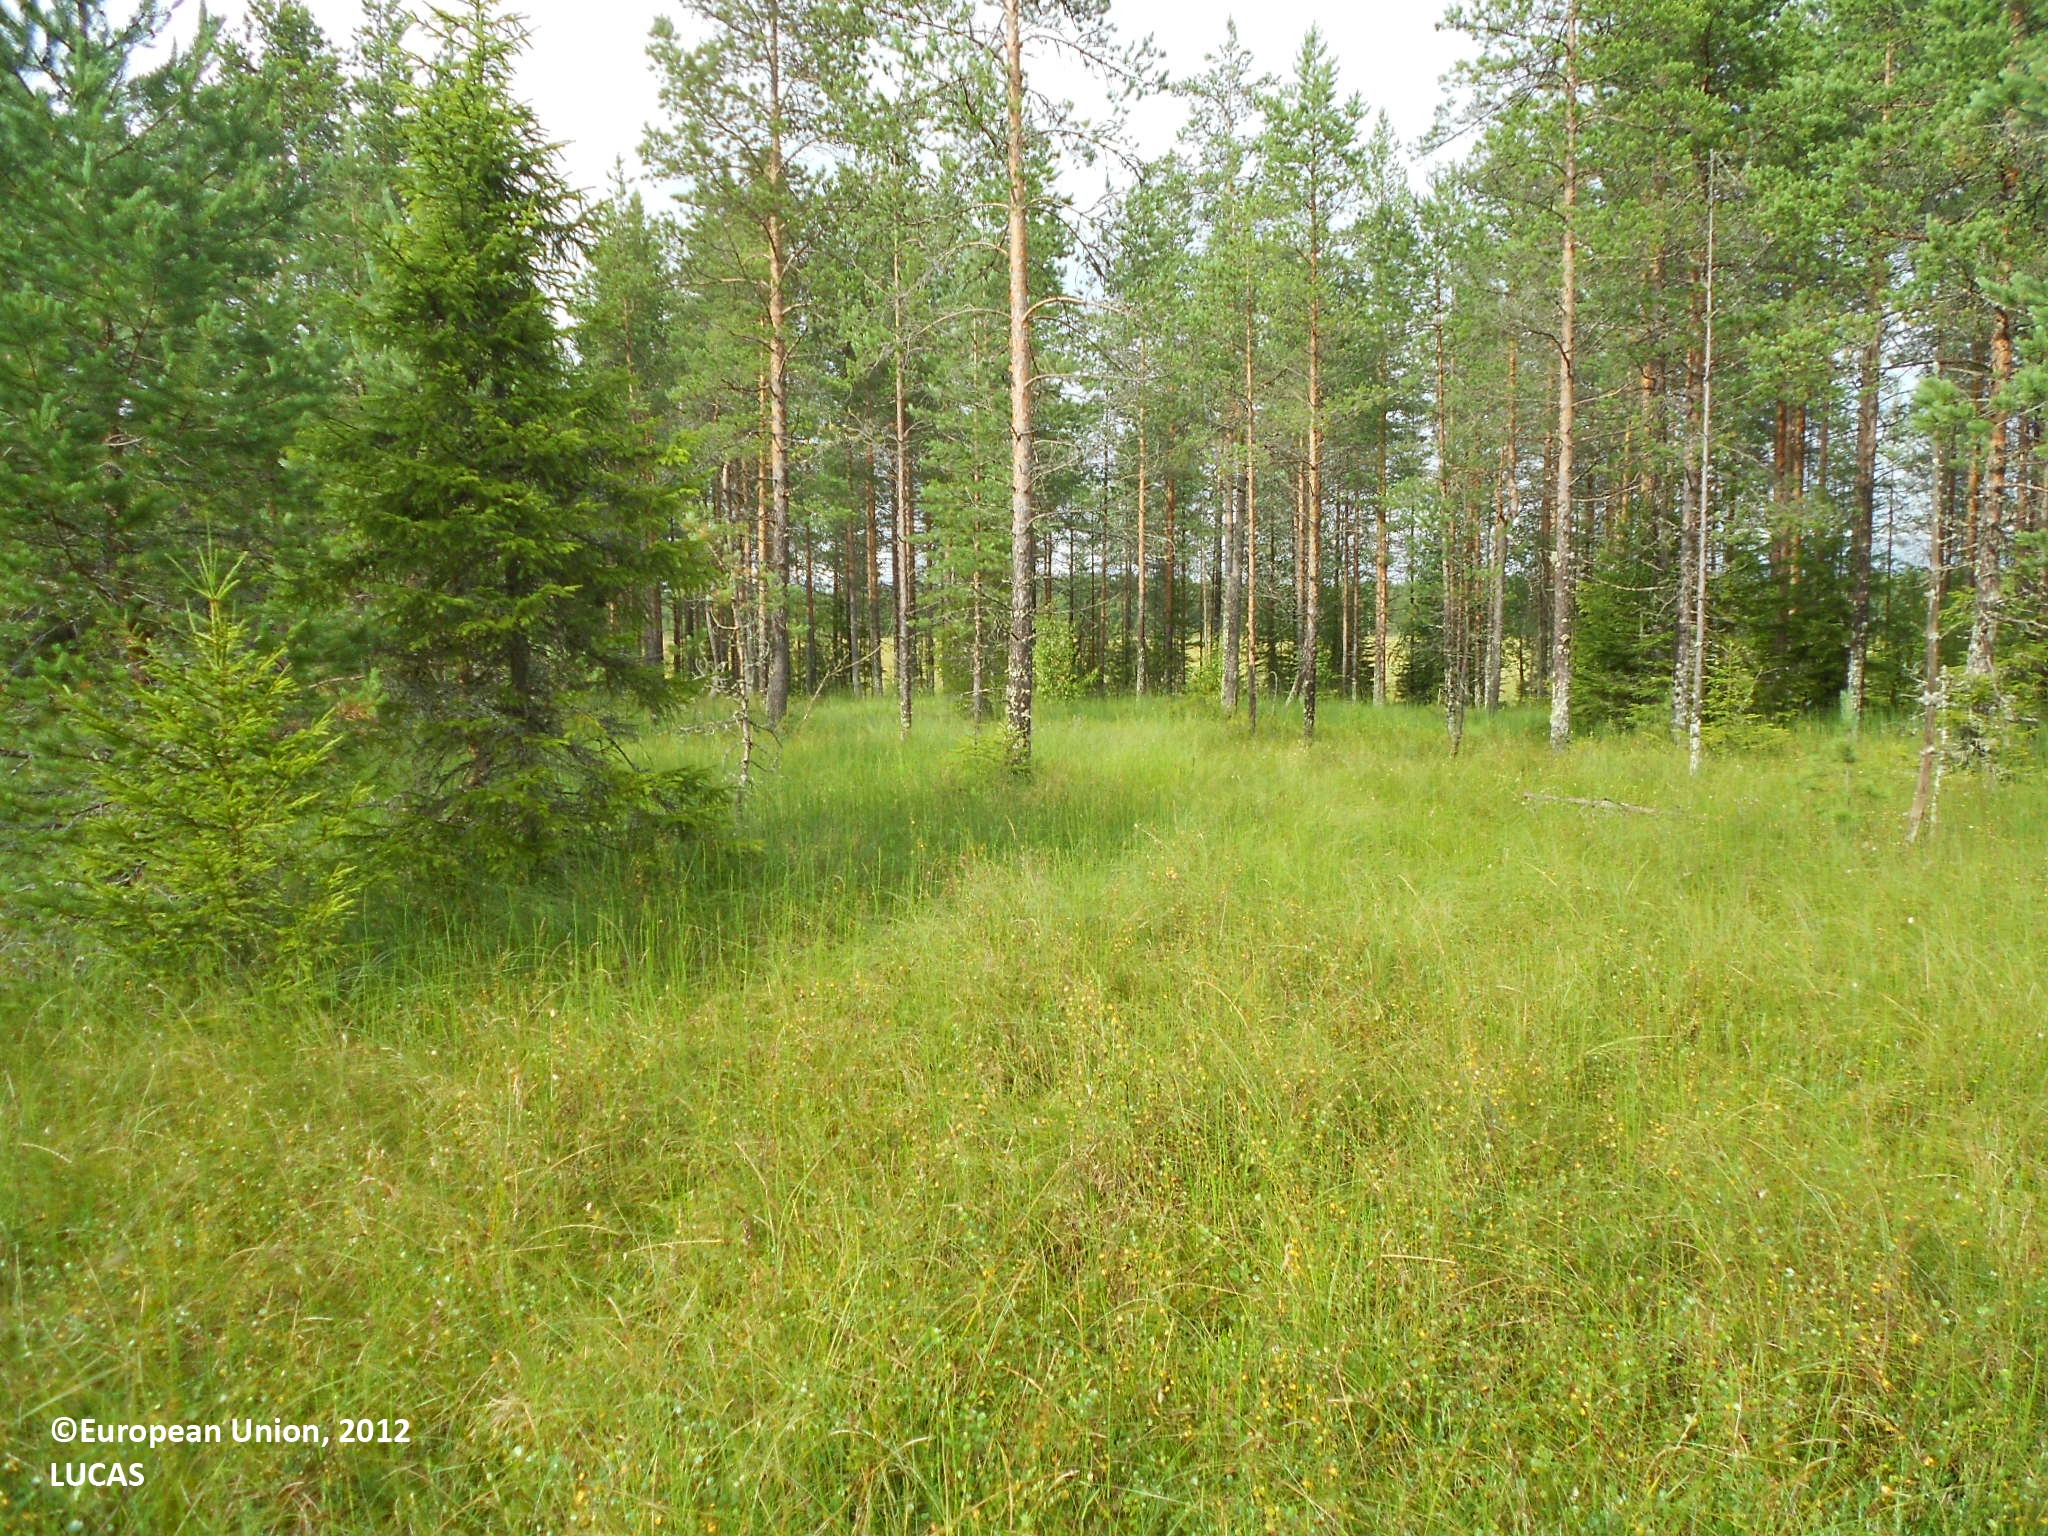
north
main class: Woodland
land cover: Pine dominated coniferous woodland
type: boreal forest
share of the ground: 10 - 25 %
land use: Semi-natural and natural areas not in use
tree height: > 5 m
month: August
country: FI
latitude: 63.5746
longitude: 28.4958
